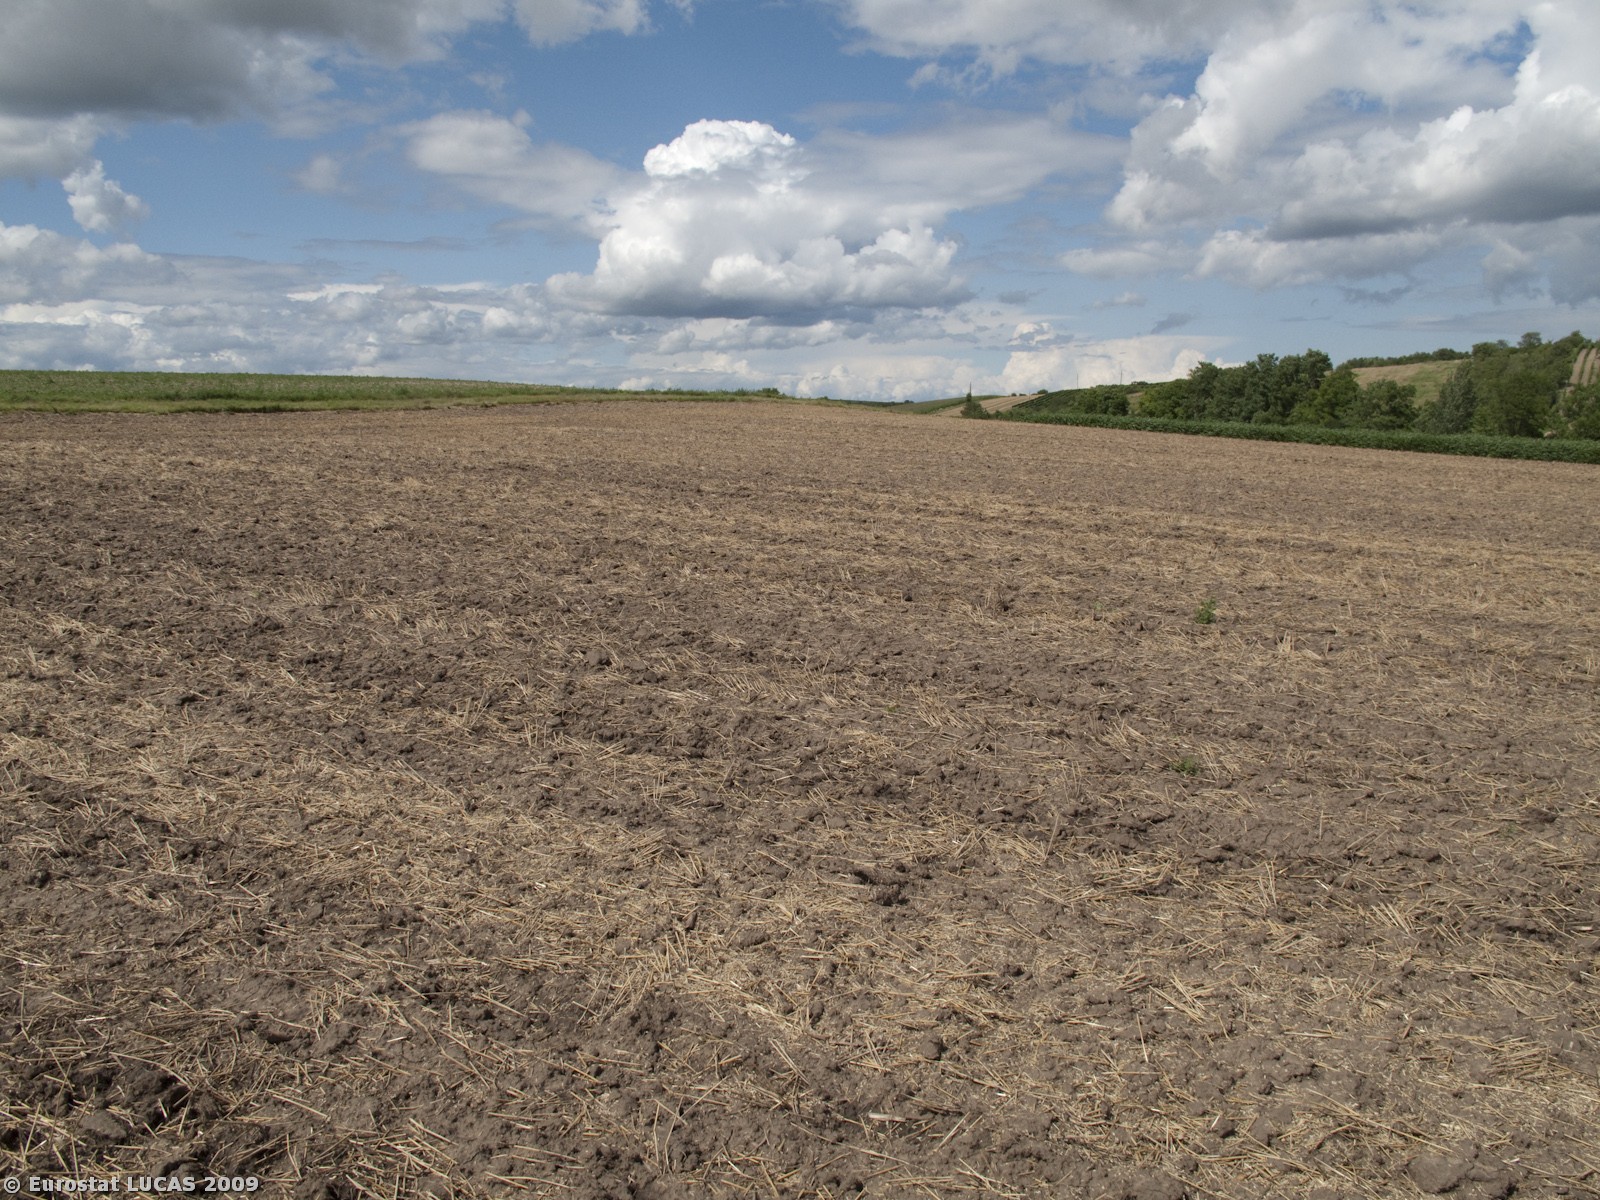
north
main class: Cropland
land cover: Common wheat
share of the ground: < 10 %
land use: Agriculture (excluding fallow land and kitchen gardens)
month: July
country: AT
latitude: 48.7441
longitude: 16.0291
